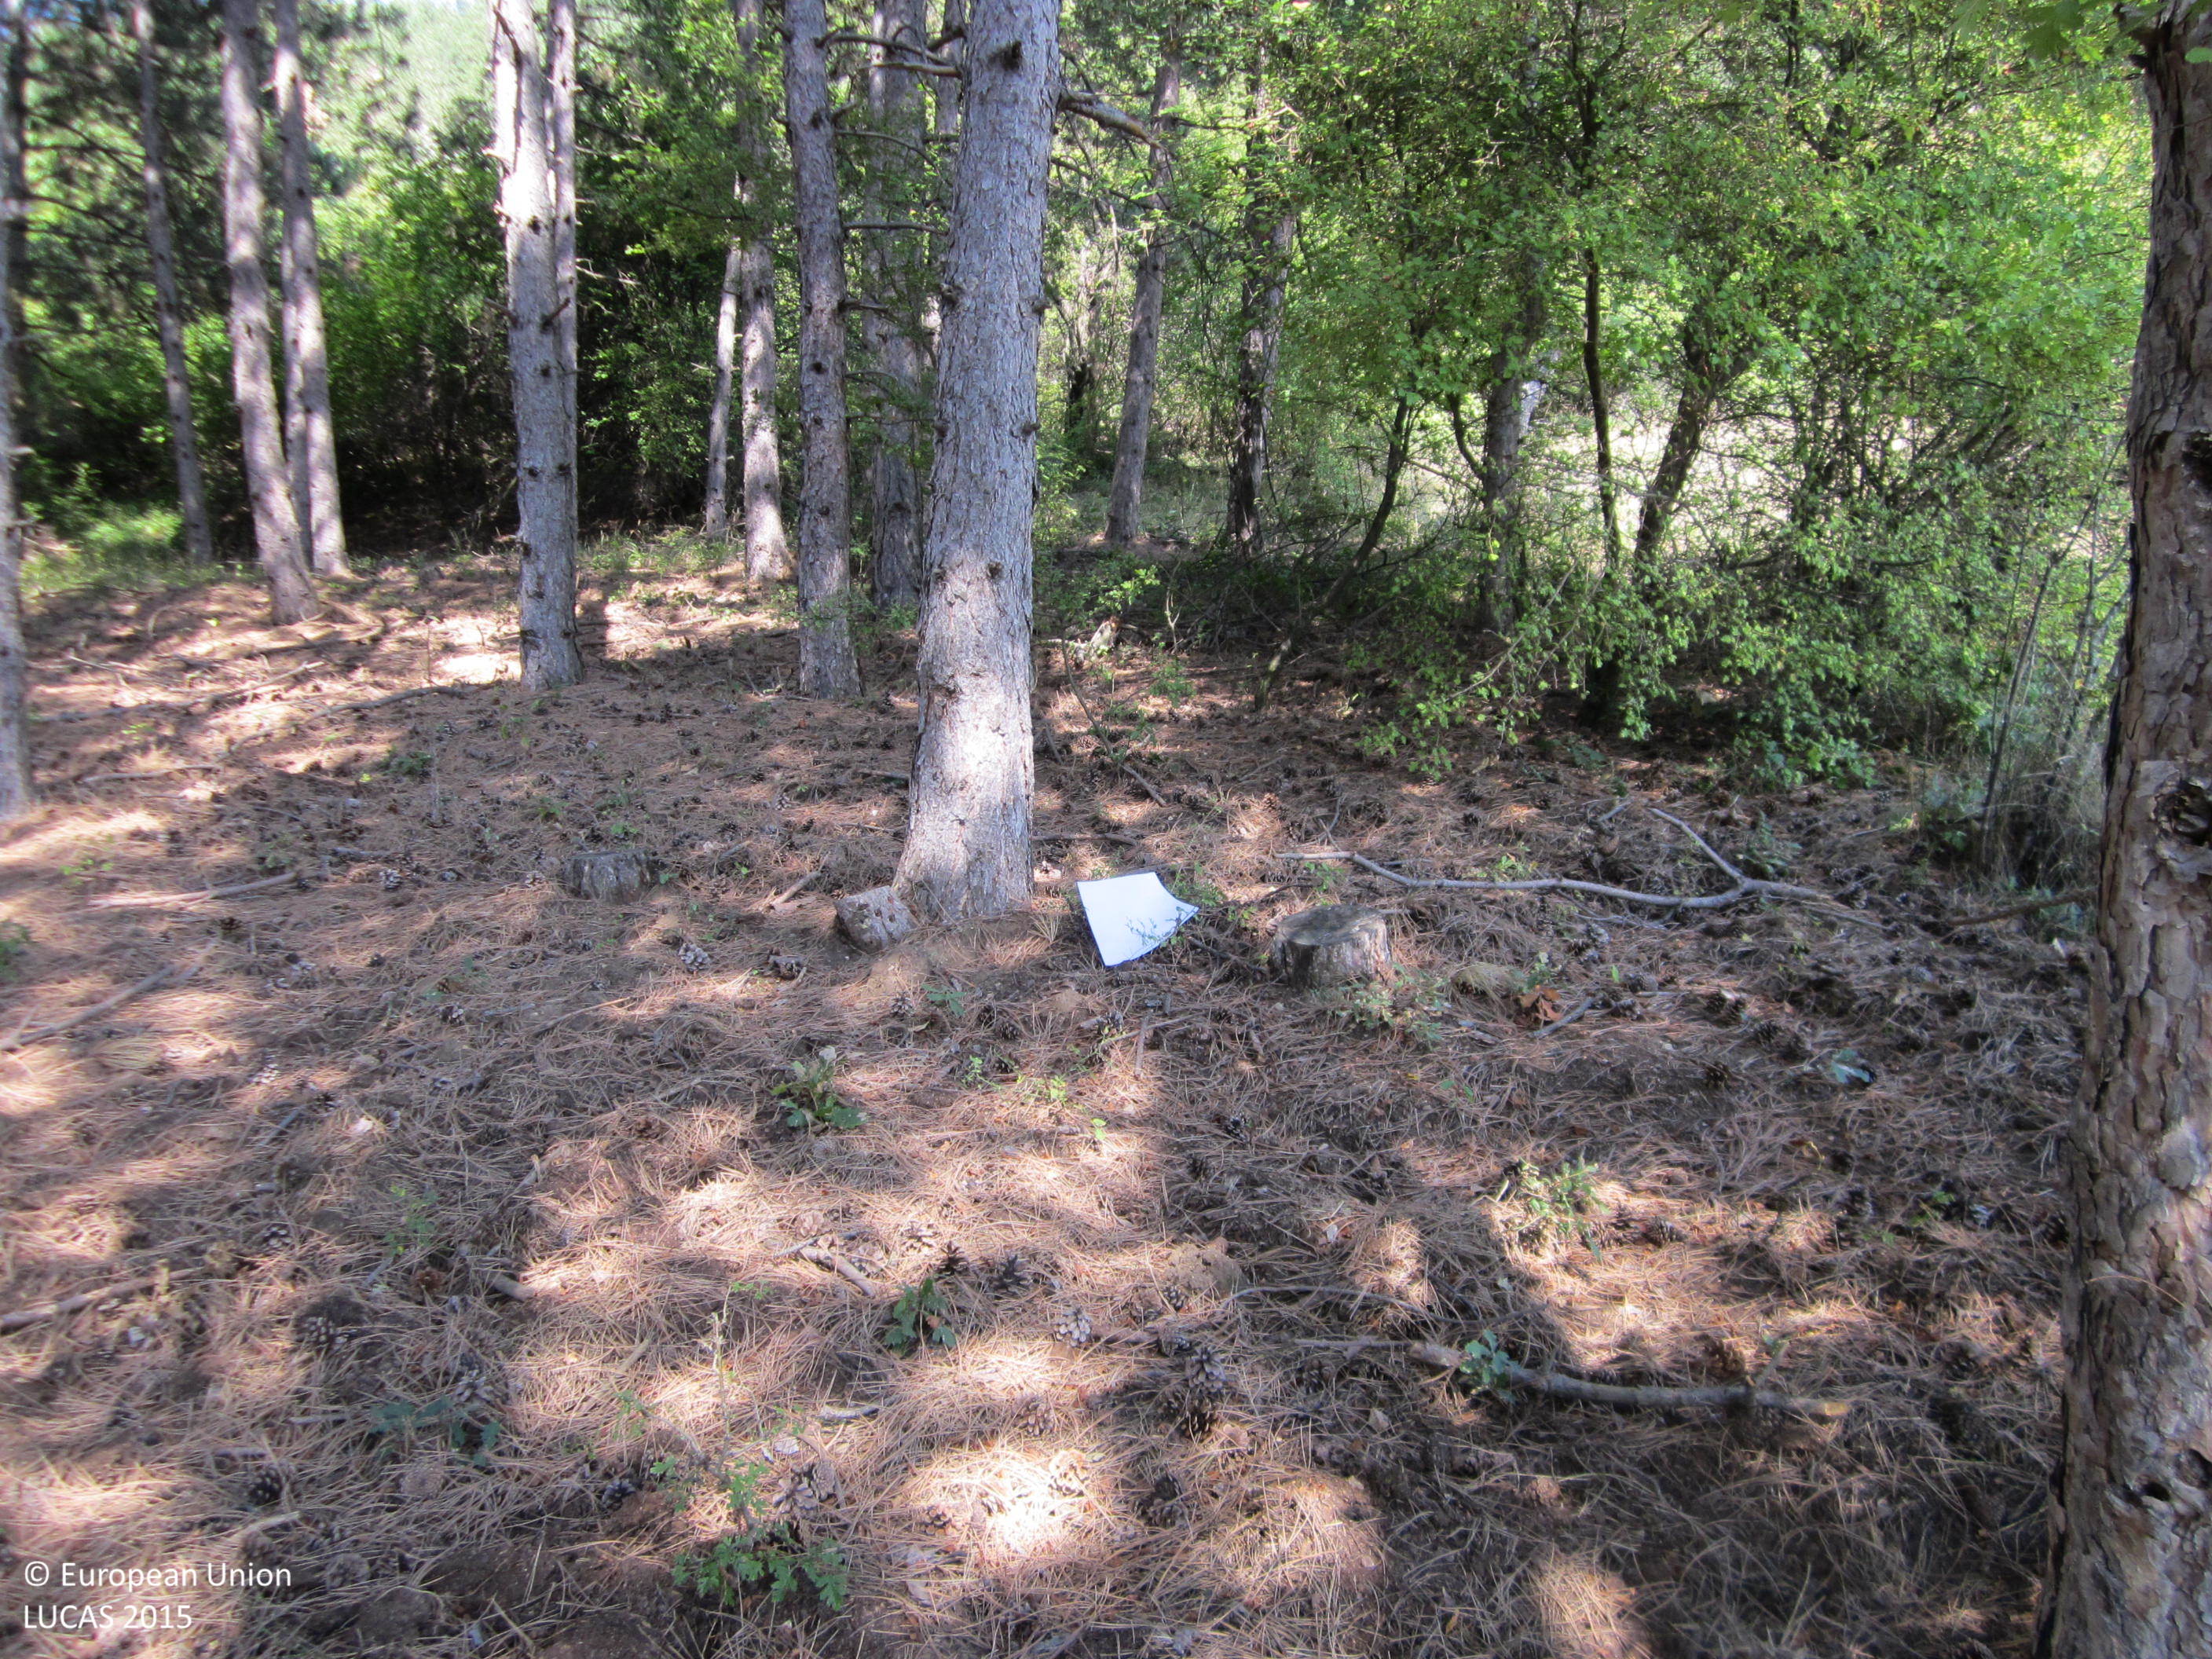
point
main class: Woodland
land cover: Pine dominated coniferous woodland
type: hemiboreal forest and nemoral coniferous forest and mixed broadleaved-coniferous forest
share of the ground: > 75 %
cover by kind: coniferous forest trees 90 %, unconsolidated bare surface 10 %
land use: Forestry
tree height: > 5 m
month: September
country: BG
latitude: 42.8542
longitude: 26.9347
